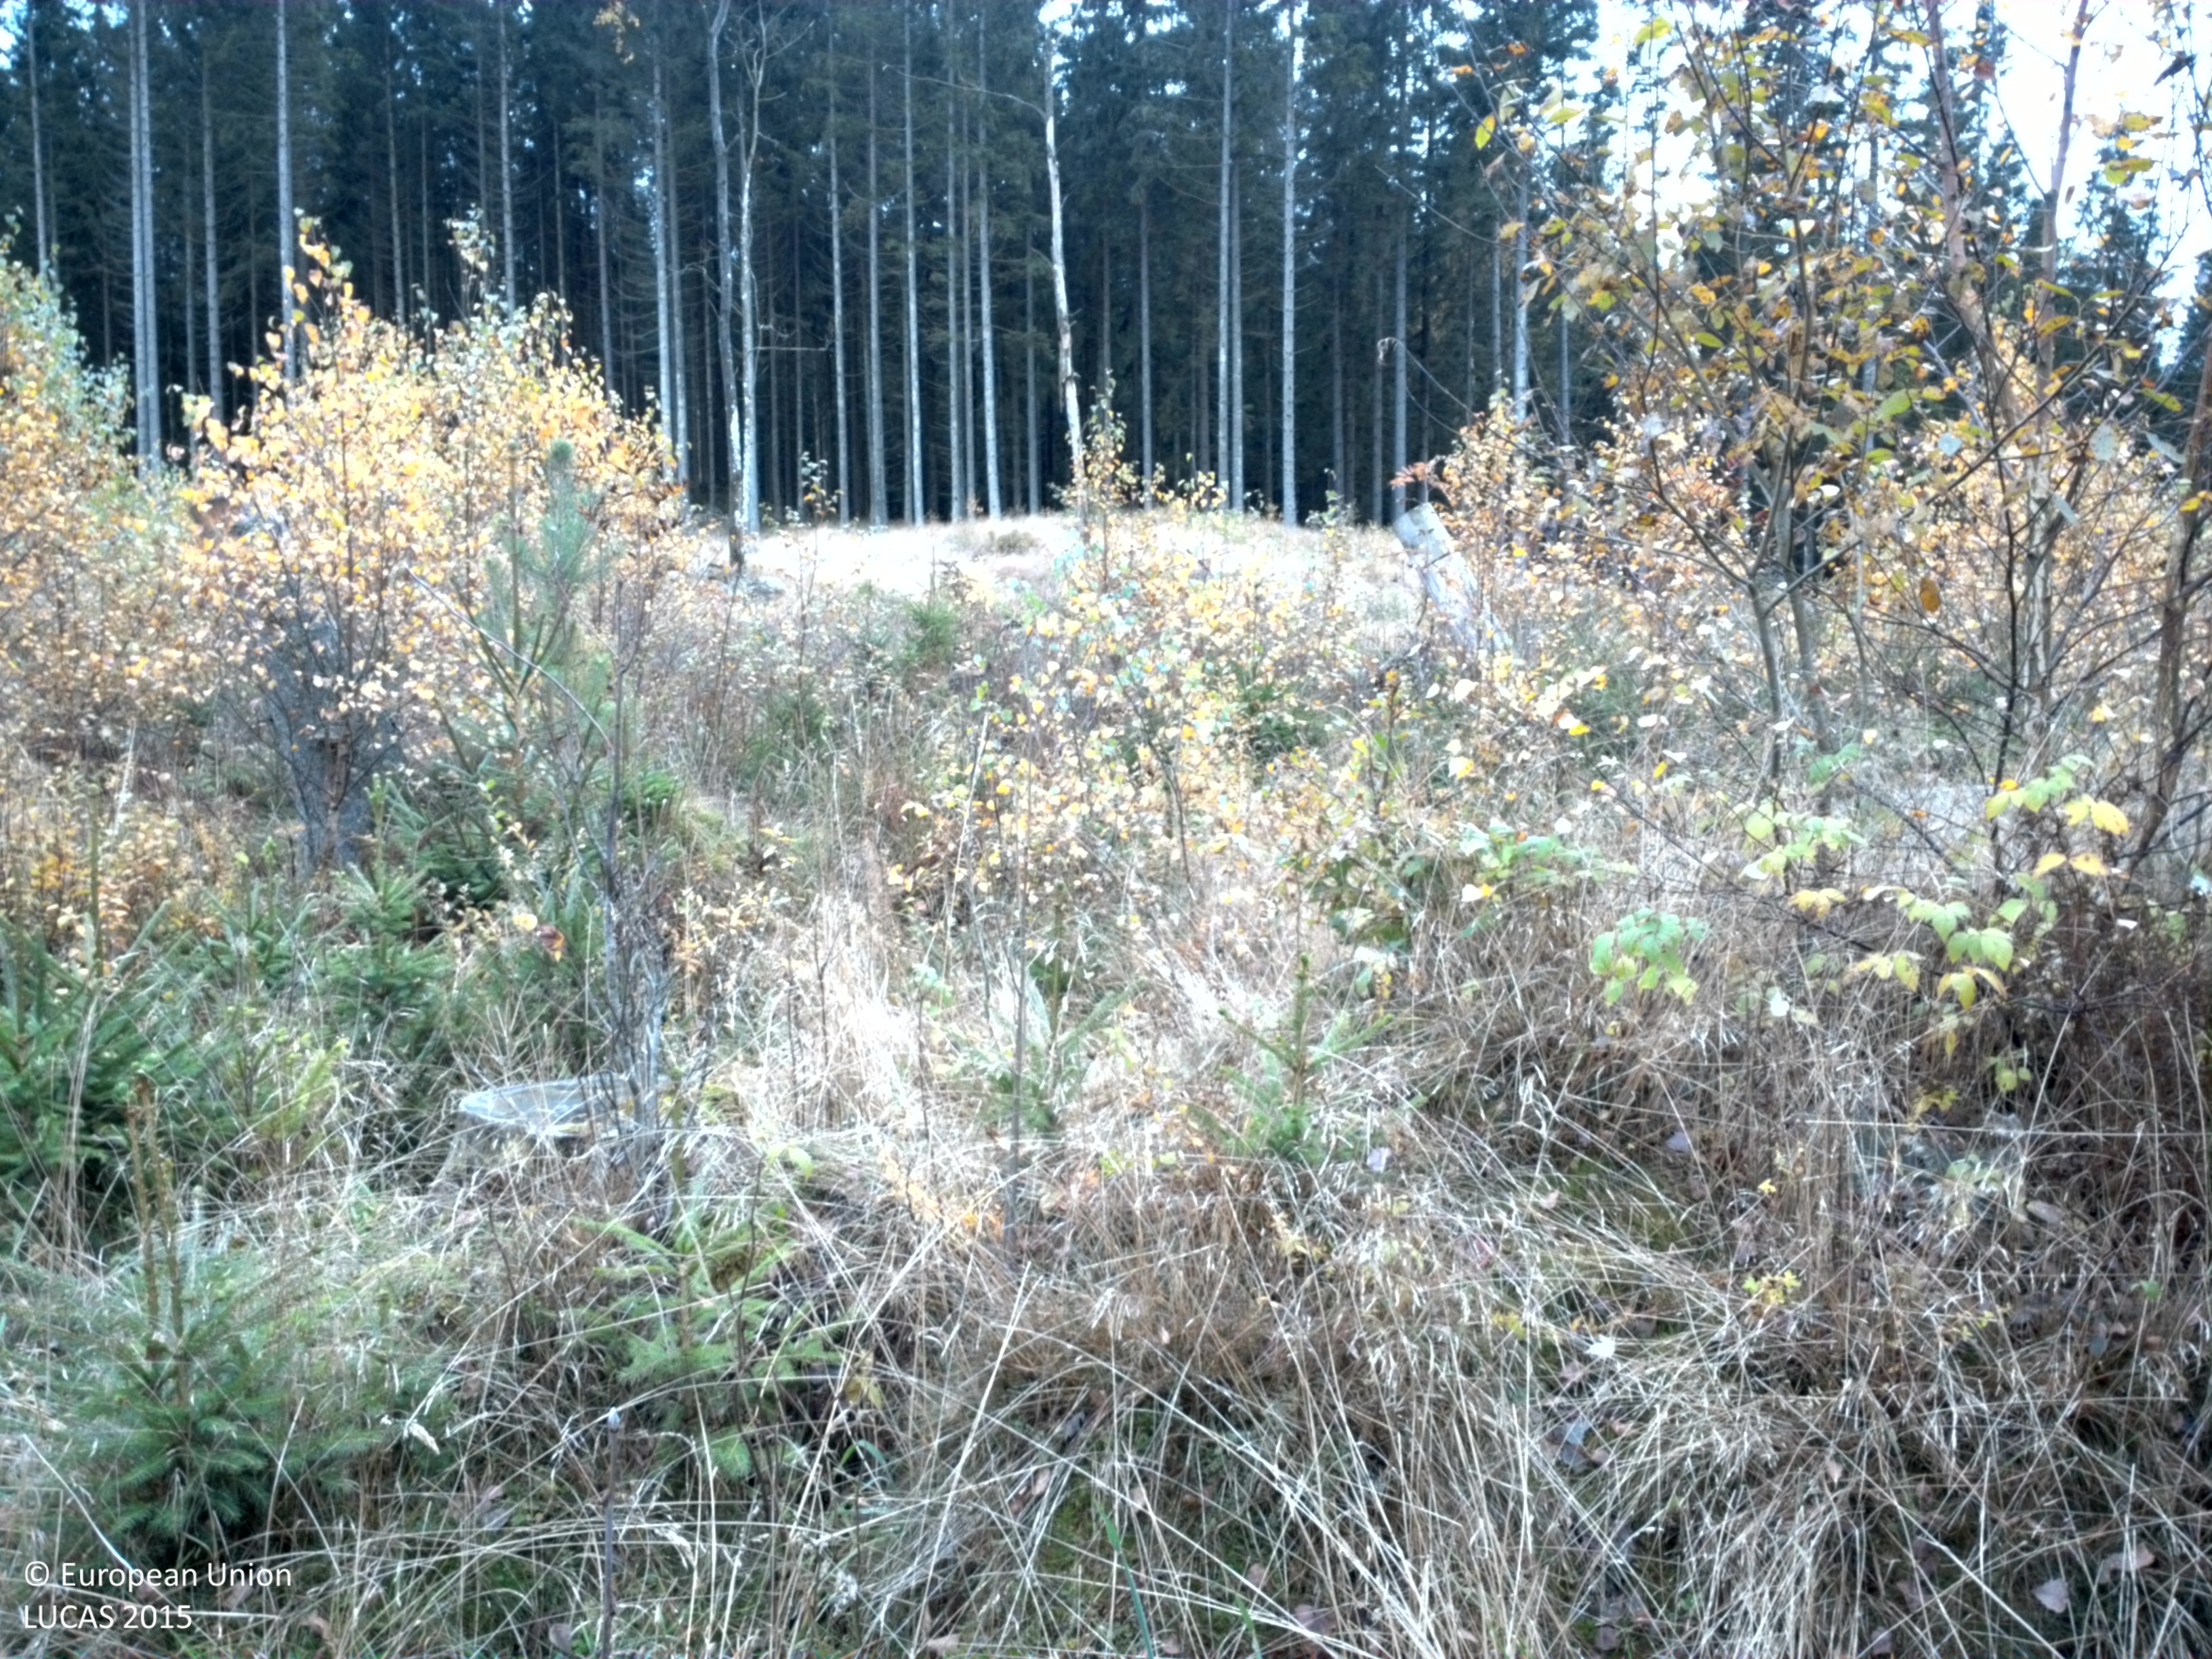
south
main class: Woodland
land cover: Other mixed woodland
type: hemiboreal forest and nemoral coniferous forest and mixed broadleaved-coniferous forest
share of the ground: 50 - 75 %
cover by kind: broadleaved forest trees 50 %, herbaceous plants 25 %, coniferous forest trees 20 %, shrubs 5 %
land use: Forestry
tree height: < 5 m
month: October
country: SE
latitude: 55.9367
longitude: 13.6958
